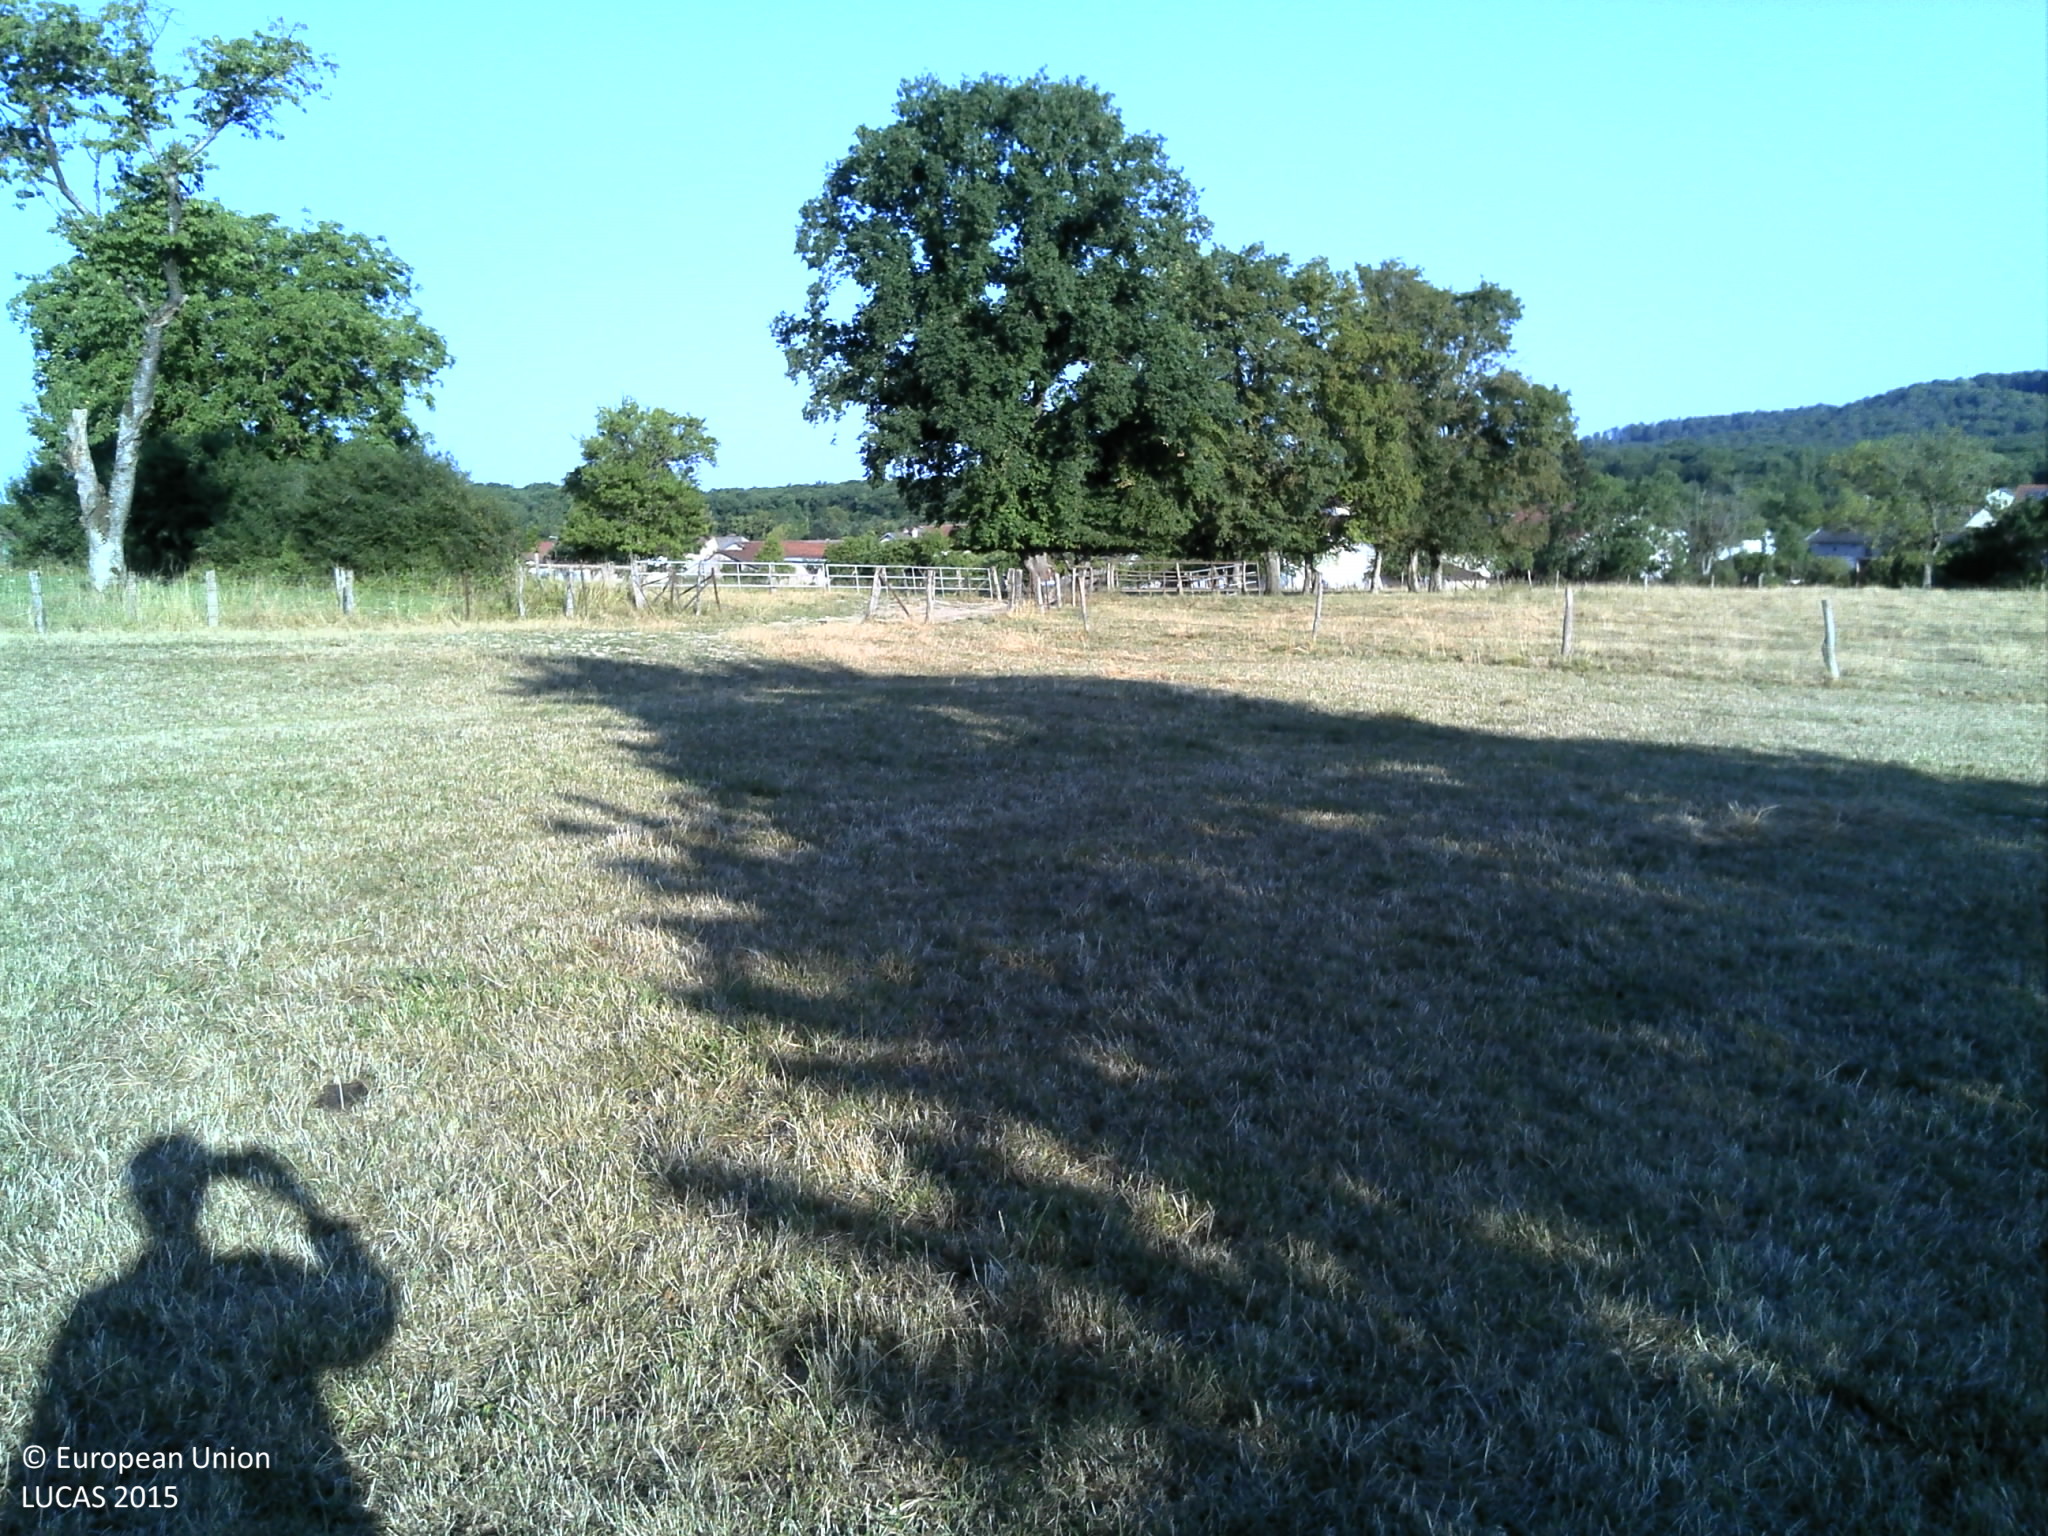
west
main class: Grassland
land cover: Grassland with sparse tree/shrub cover
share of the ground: > 75 %
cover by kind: herbaceous plants 95 %, broadleaved forest trees 5 %
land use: Agriculture (excluding fallow land and kitchen gardens)
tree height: > 5 m
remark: Harvested field
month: July
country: FR
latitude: 48.2052
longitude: 6.0039
